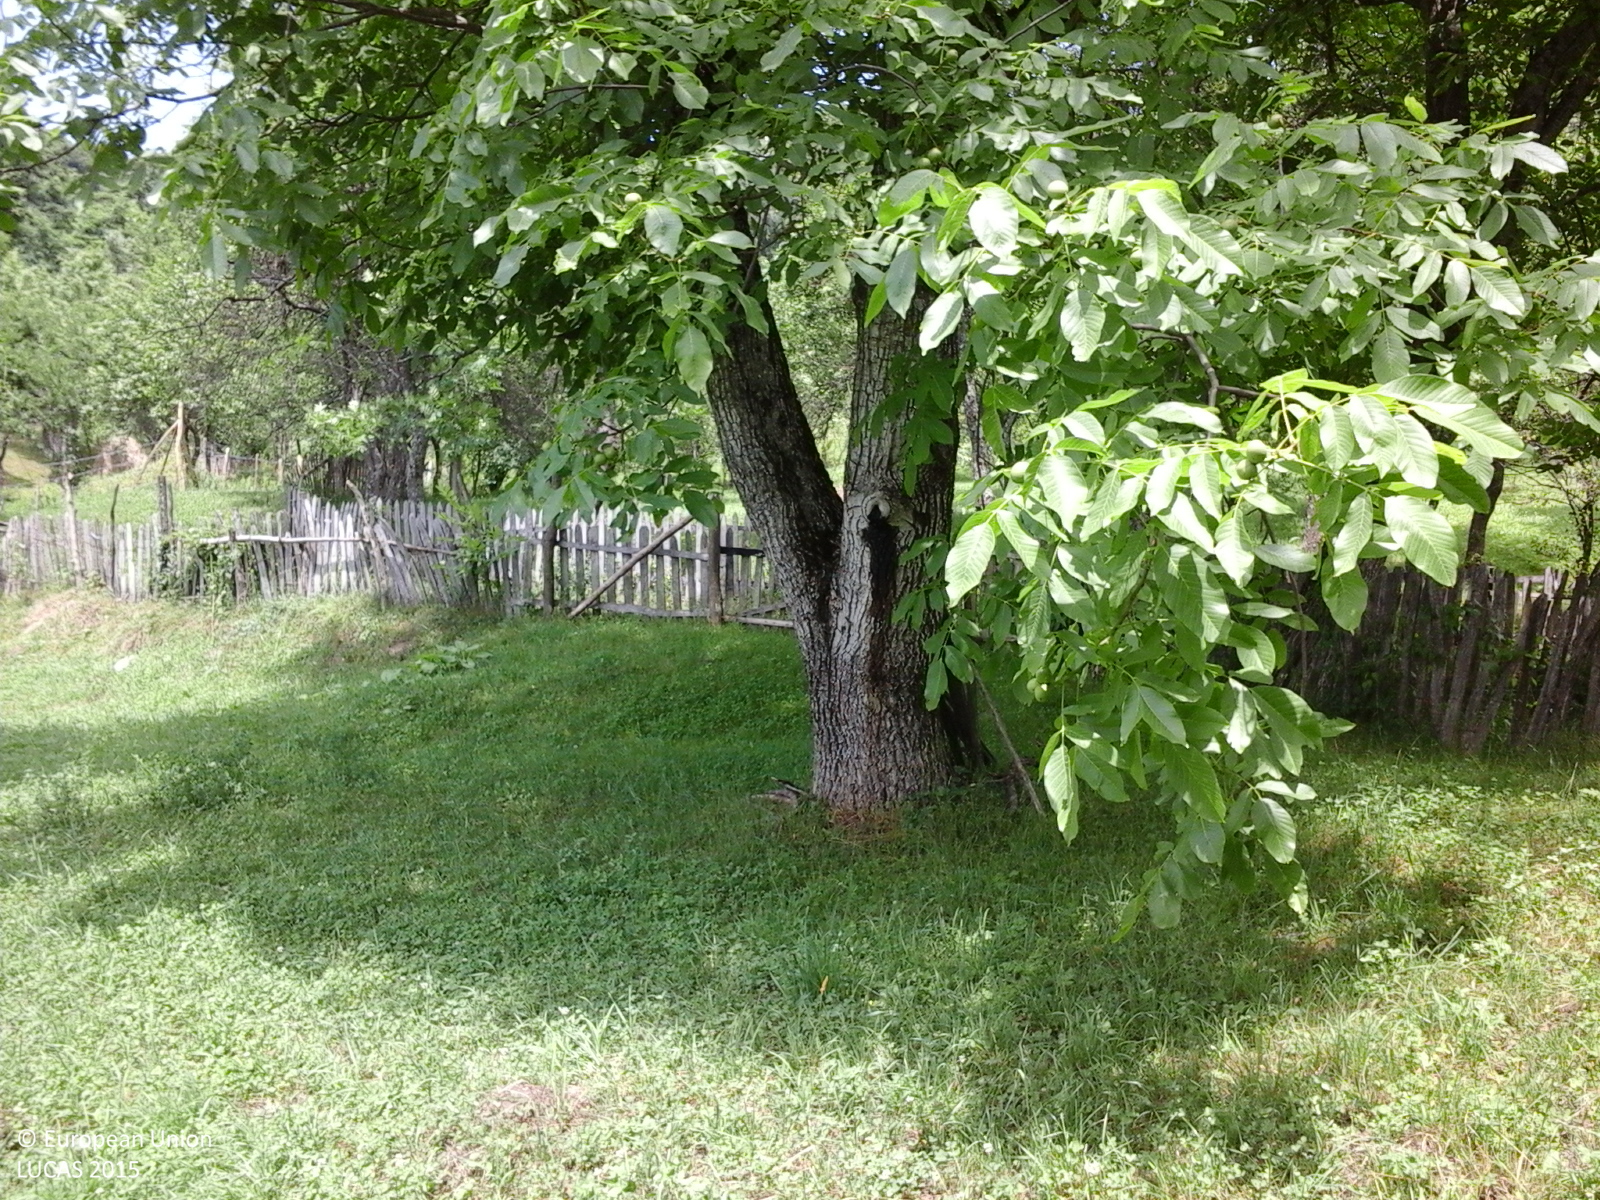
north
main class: Cropland
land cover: Apple fruit
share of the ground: > 75 %
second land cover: Grassland without tree/shrub cover
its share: > 75 %
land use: Agriculture (excluding fallow land and kitchen gardens)
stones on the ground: < 10 %
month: July
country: RO
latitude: 45.3405
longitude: 24.6161
